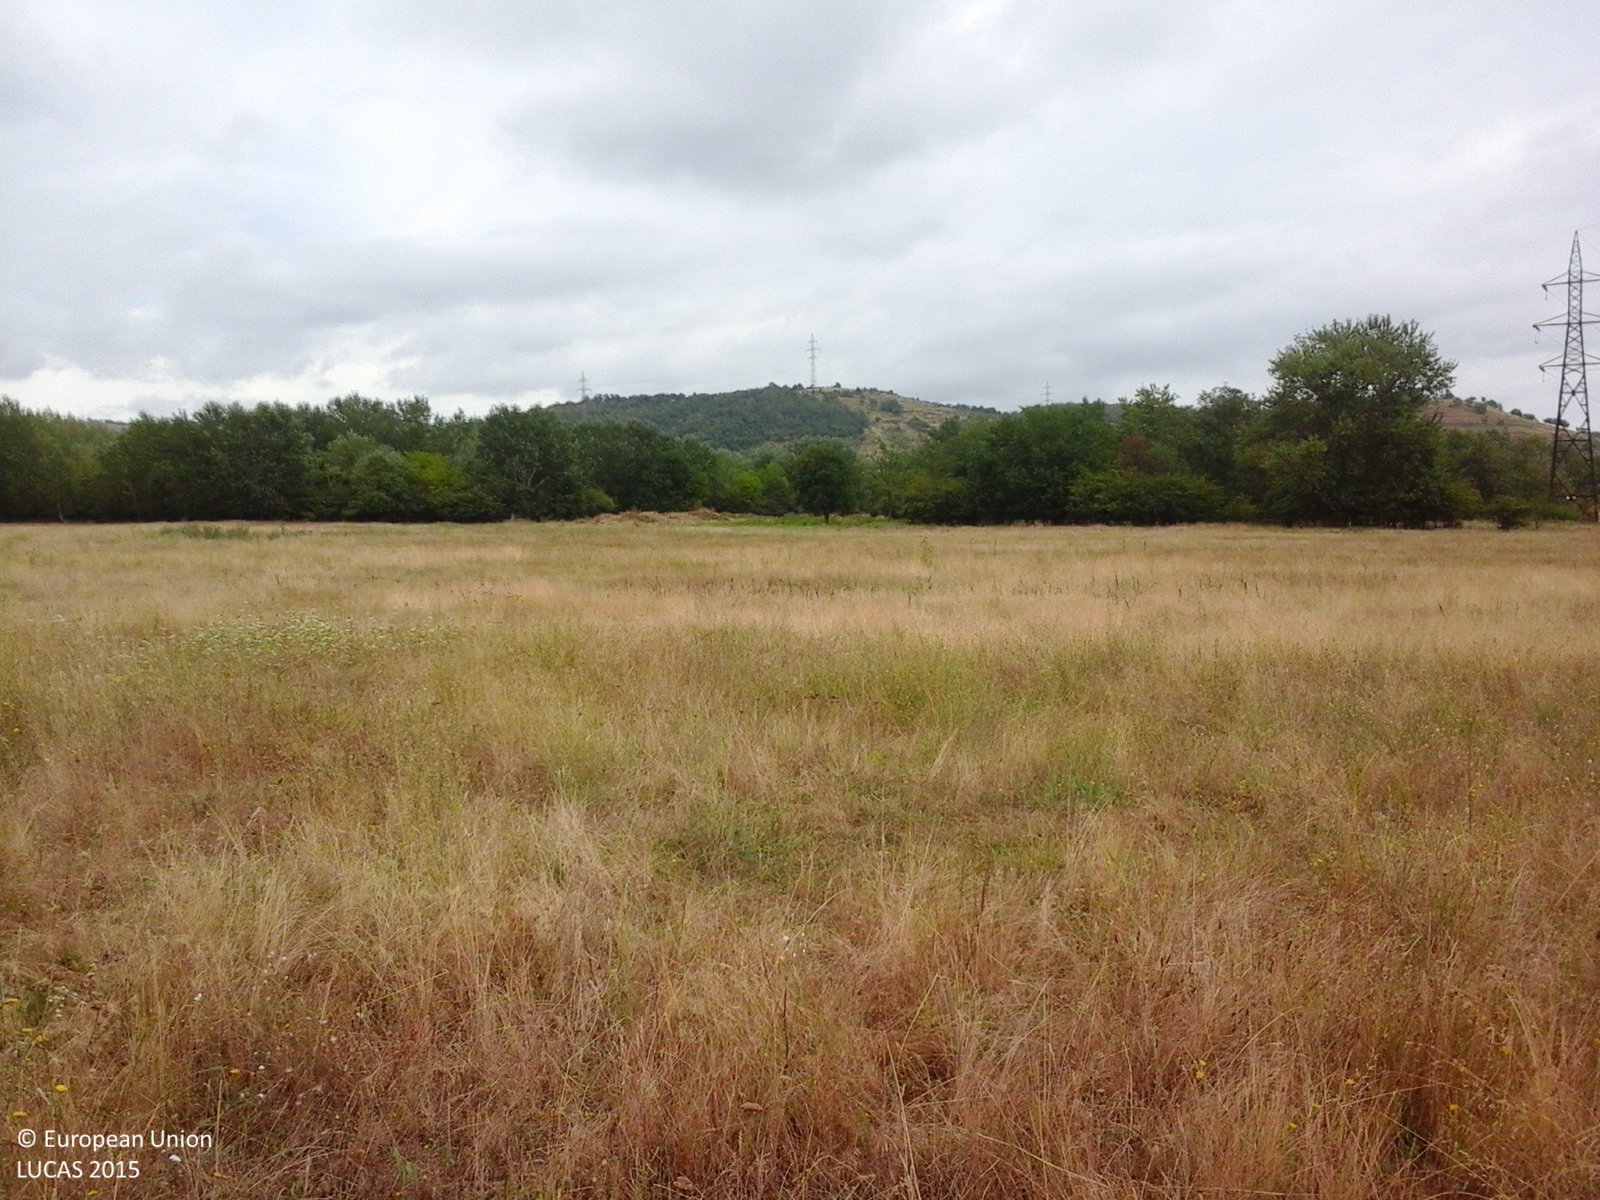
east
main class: Grassland
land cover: Grassland without tree/shrub cover
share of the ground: > 75 %
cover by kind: herbaceous plants 100 %
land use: Agriculture (excluding fallow land and kitchen gardens)
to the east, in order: Grassland without tree/shrub cover; Tracks; Spontaneously vegetated surfaces; Broadleaved woodland
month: August
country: RO
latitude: 44.6204
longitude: 22.7337
